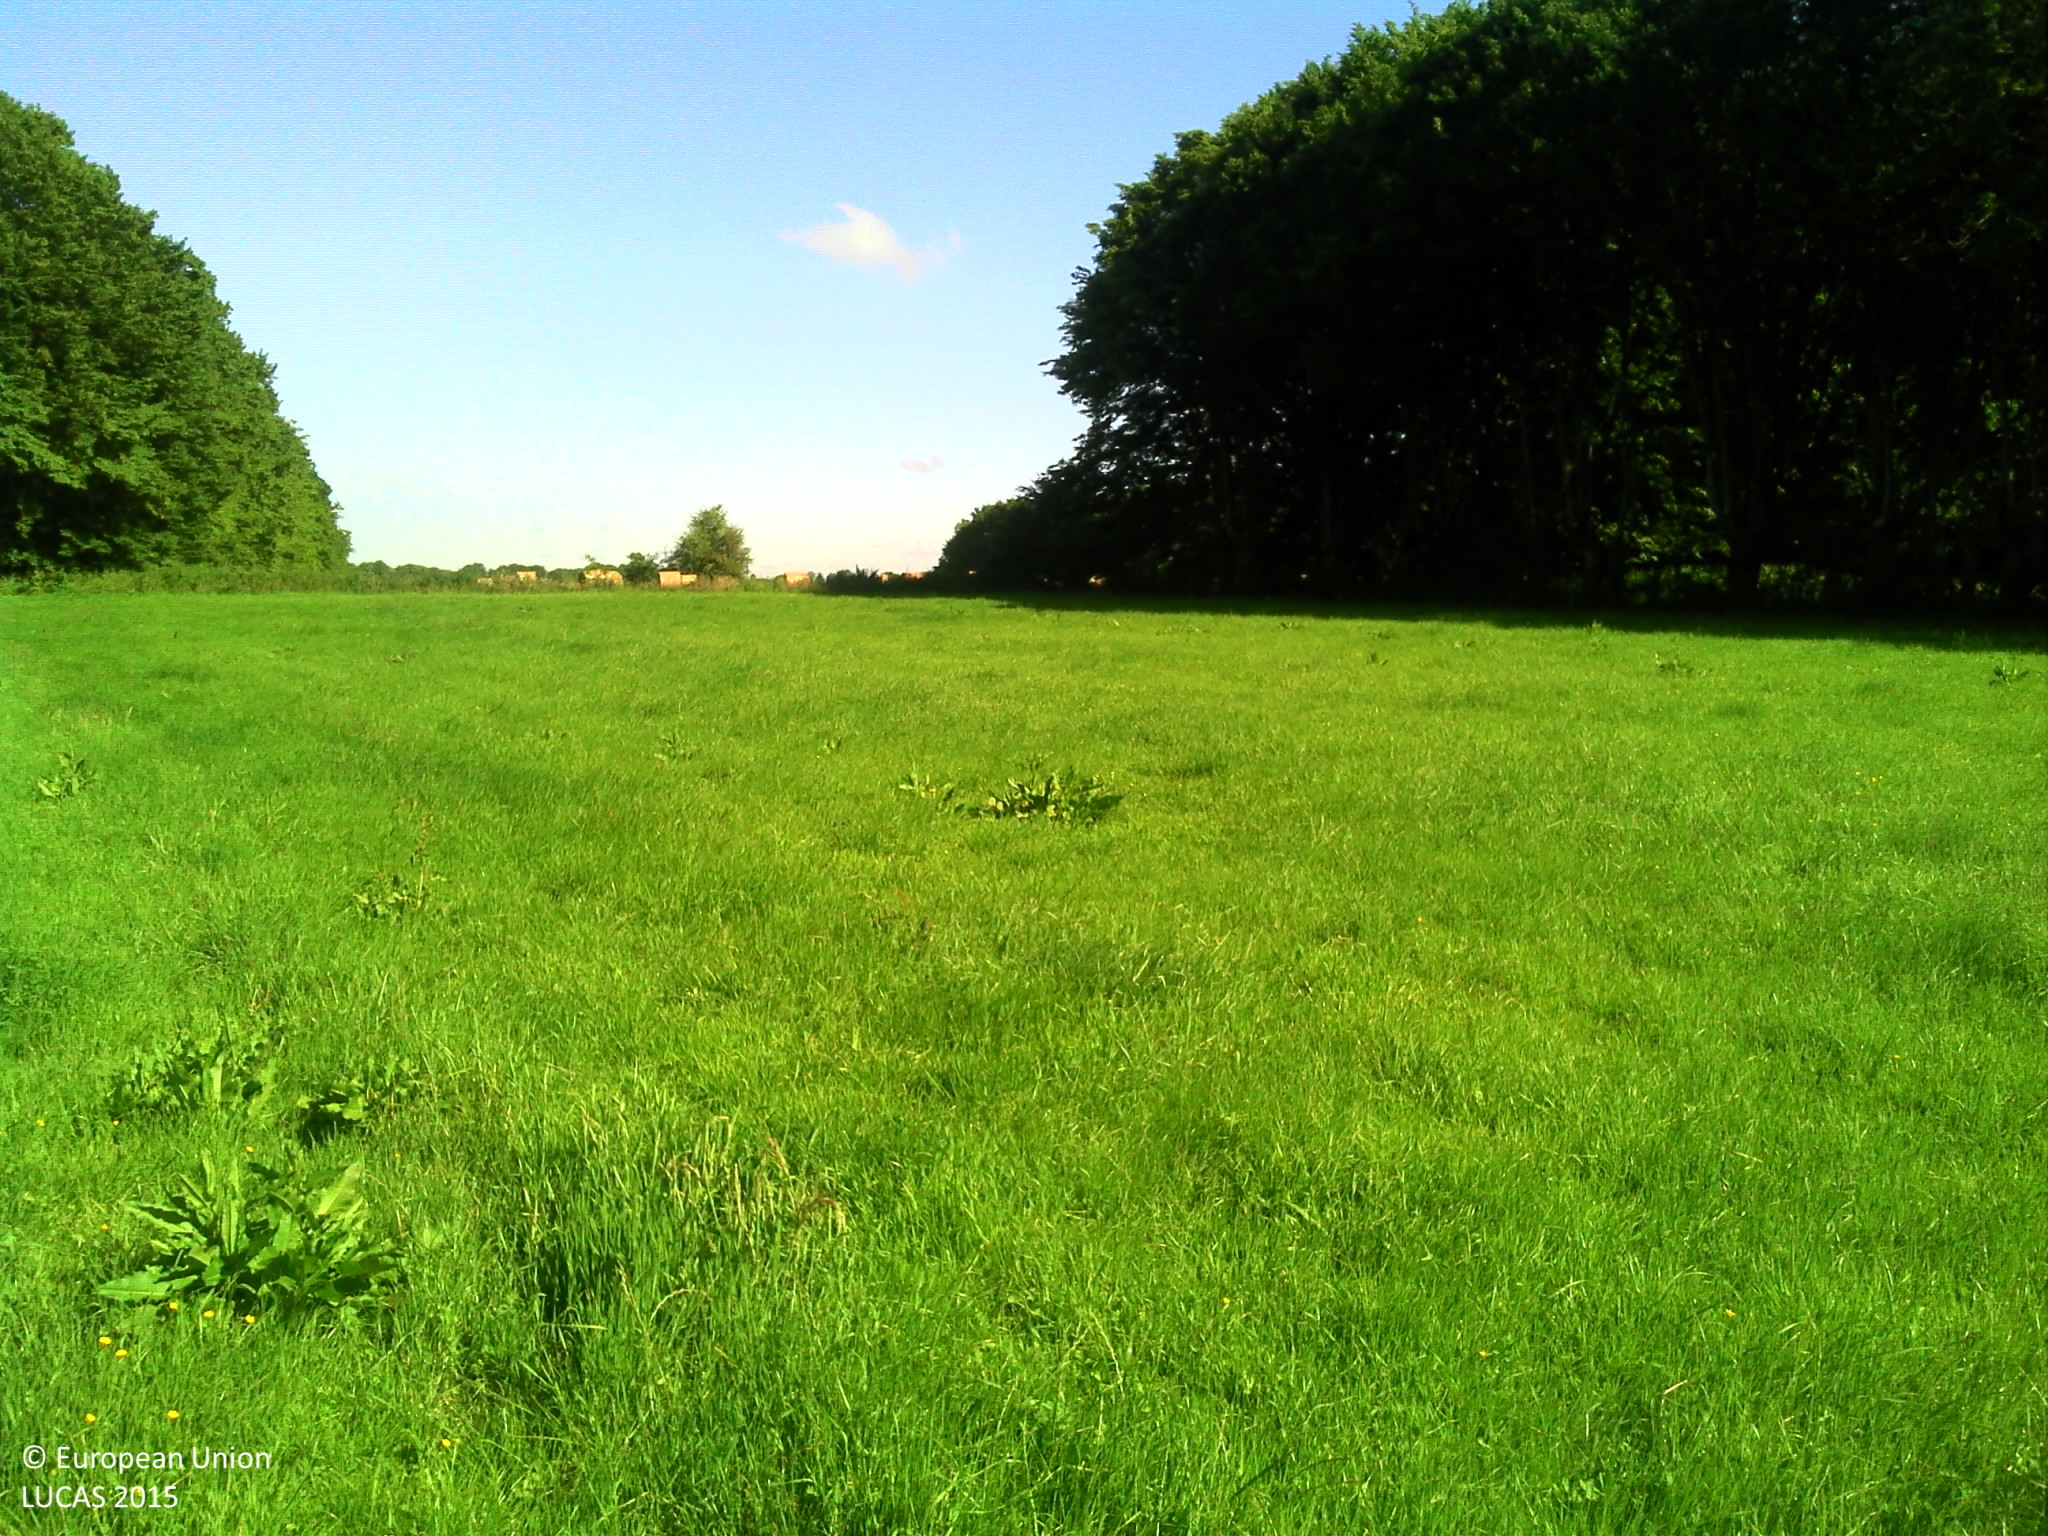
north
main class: Grassland
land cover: Grassland without tree/shrub cover
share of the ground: > 75 %
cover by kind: herbaceous plants 100 %
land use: Agriculture (excluding fallow land and kitchen gardens)
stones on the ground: < 10 %
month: June
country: FR
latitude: 49.9564
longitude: 4.0428
